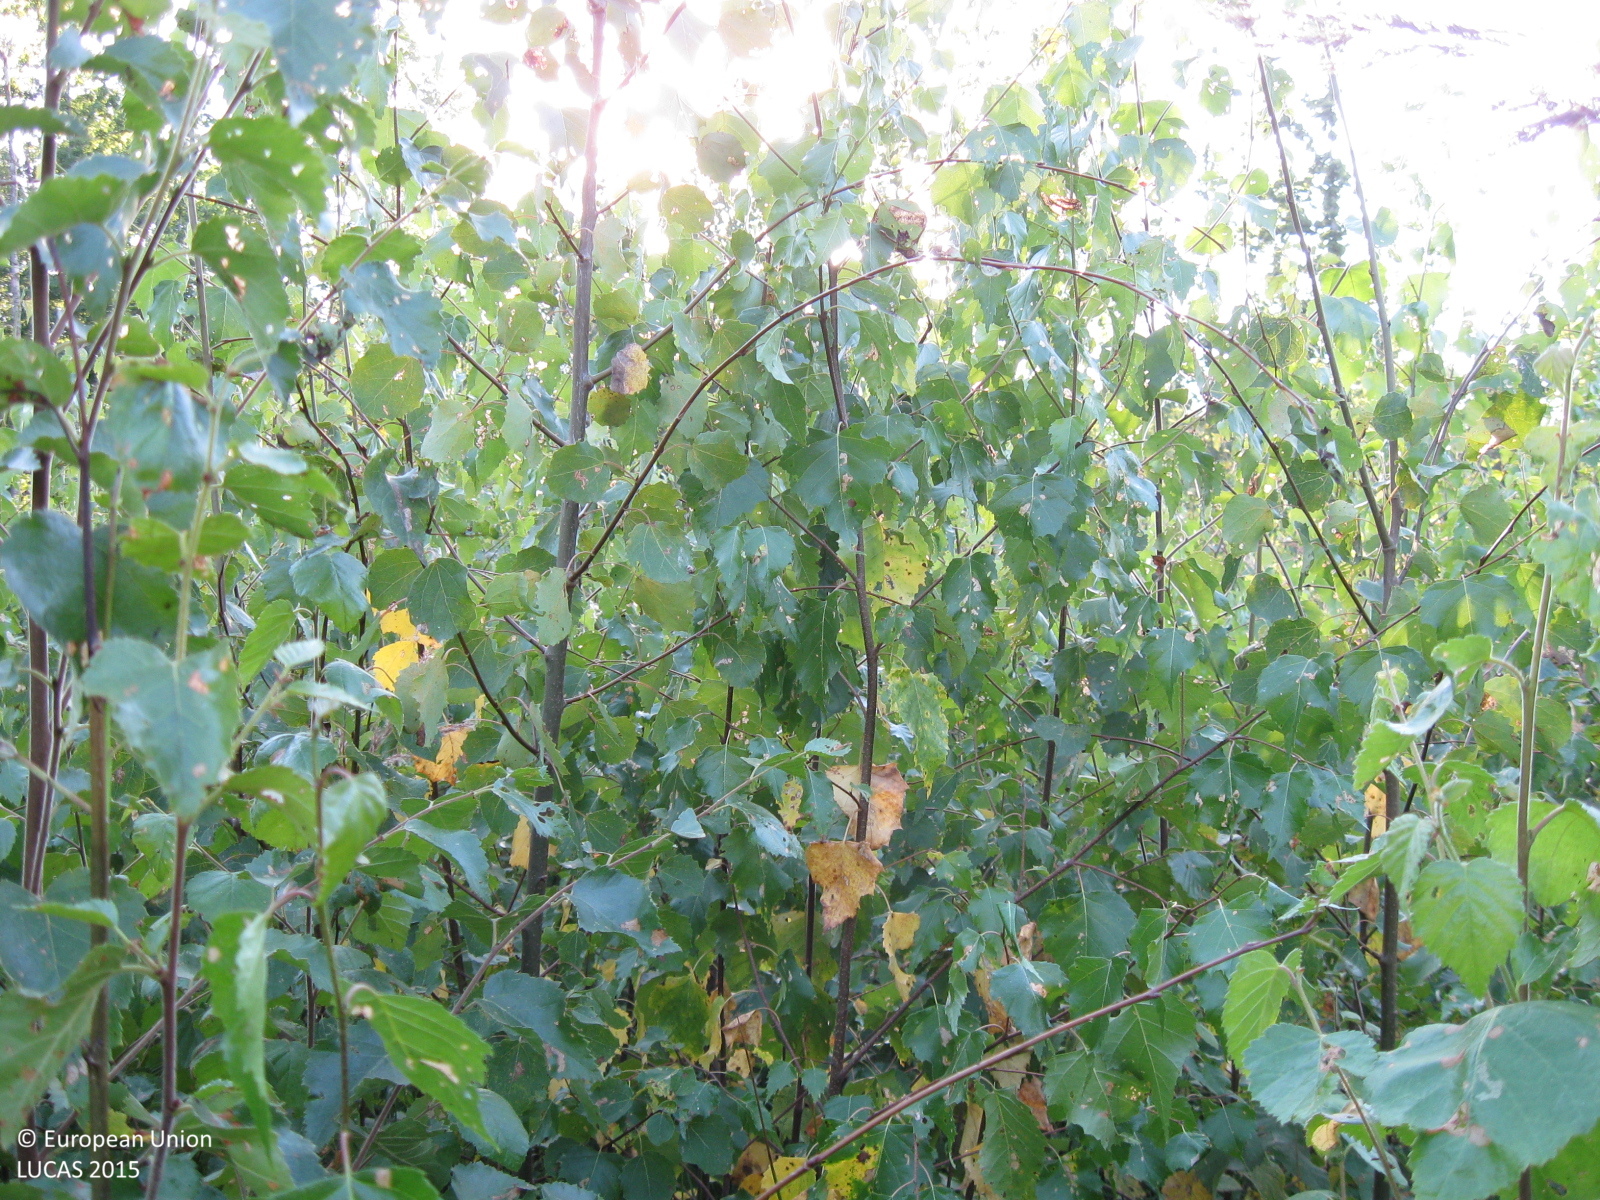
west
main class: Woodland
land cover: Broadleaved woodland
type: non-riverine alder, birch or aspen forest
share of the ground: > 75 %
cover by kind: broadleaved forest trees 90 %, coniferous forest trees 5 %, herbaceous plants 5 %
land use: Forestry
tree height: < 5 m
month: August
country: LT
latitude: 55.3626
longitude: 22.6049
